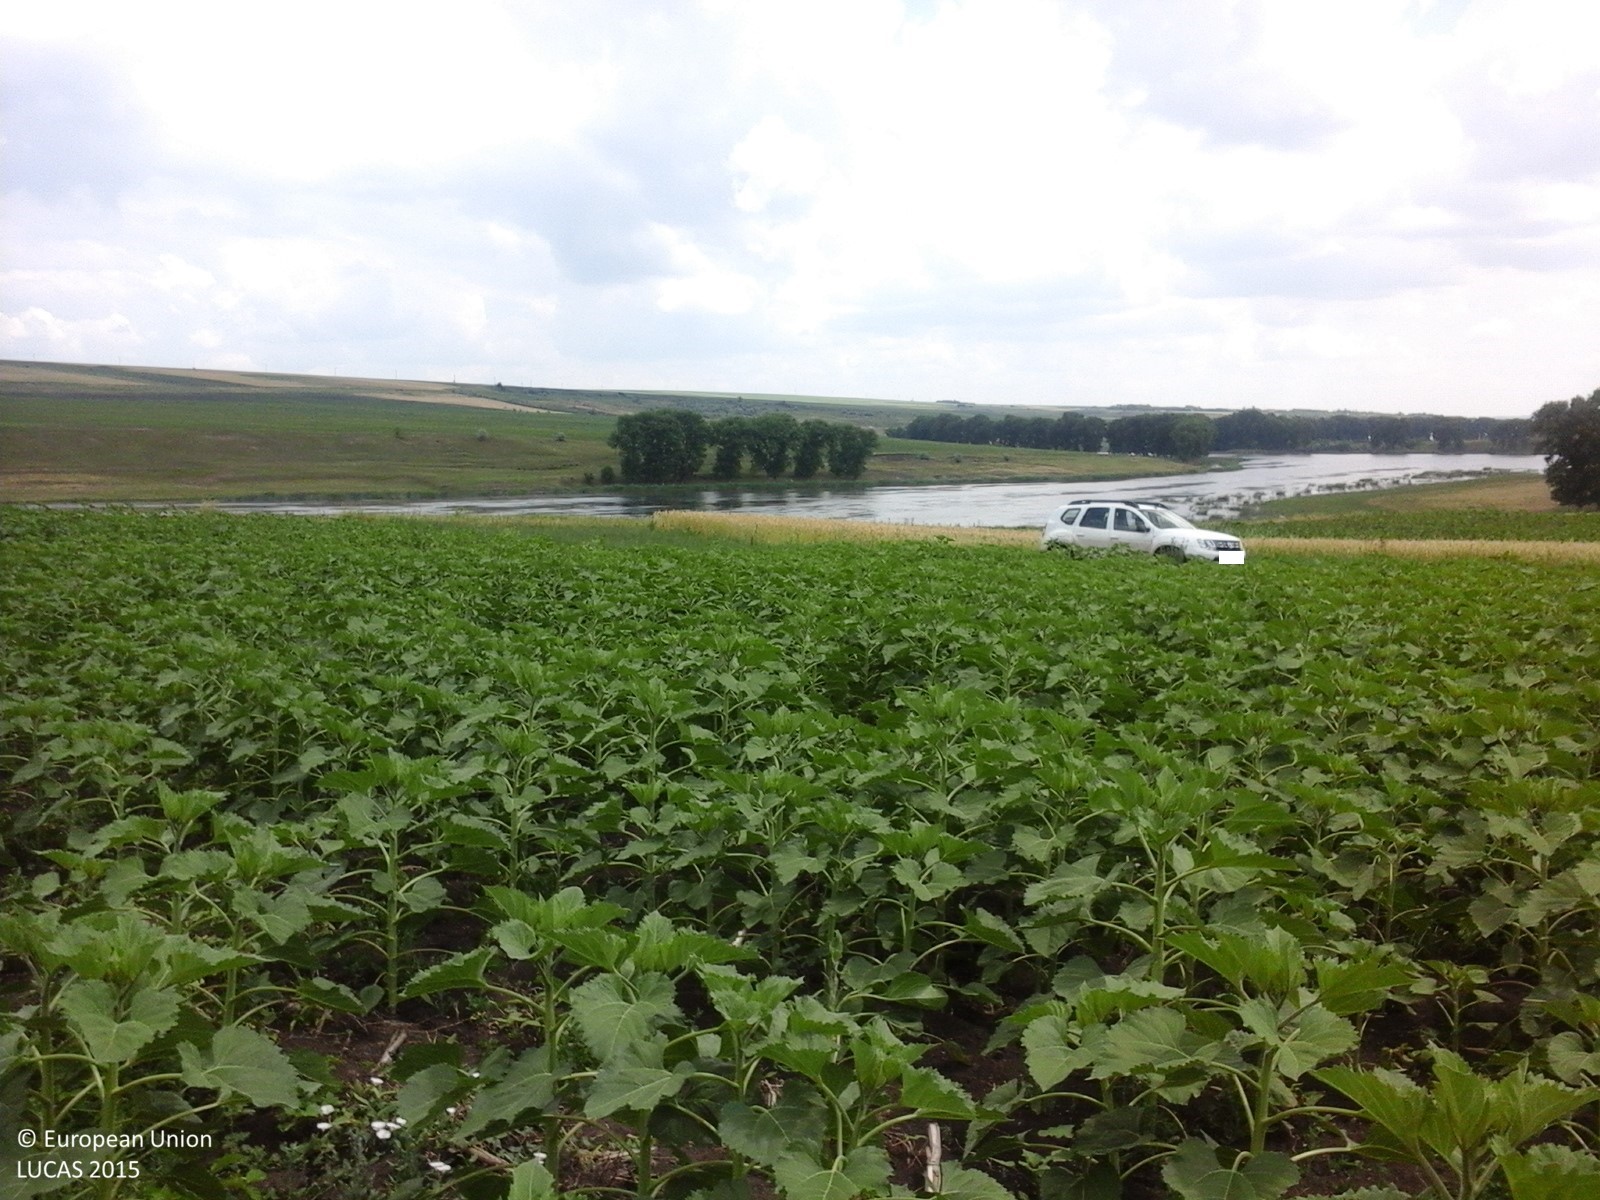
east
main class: Cropland
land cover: Sunflower
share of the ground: 25 - 50 %
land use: Agriculture (excluding fallow land and kitchen gardens)
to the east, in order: Sunflower; Lucerne; Tracks; Grassland without tree/shrub cover; Tracks; Lucerne; Tracks; Inland marshes; Inland fresh water bodies
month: June
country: RO
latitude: 48.0200
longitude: 26.7103
